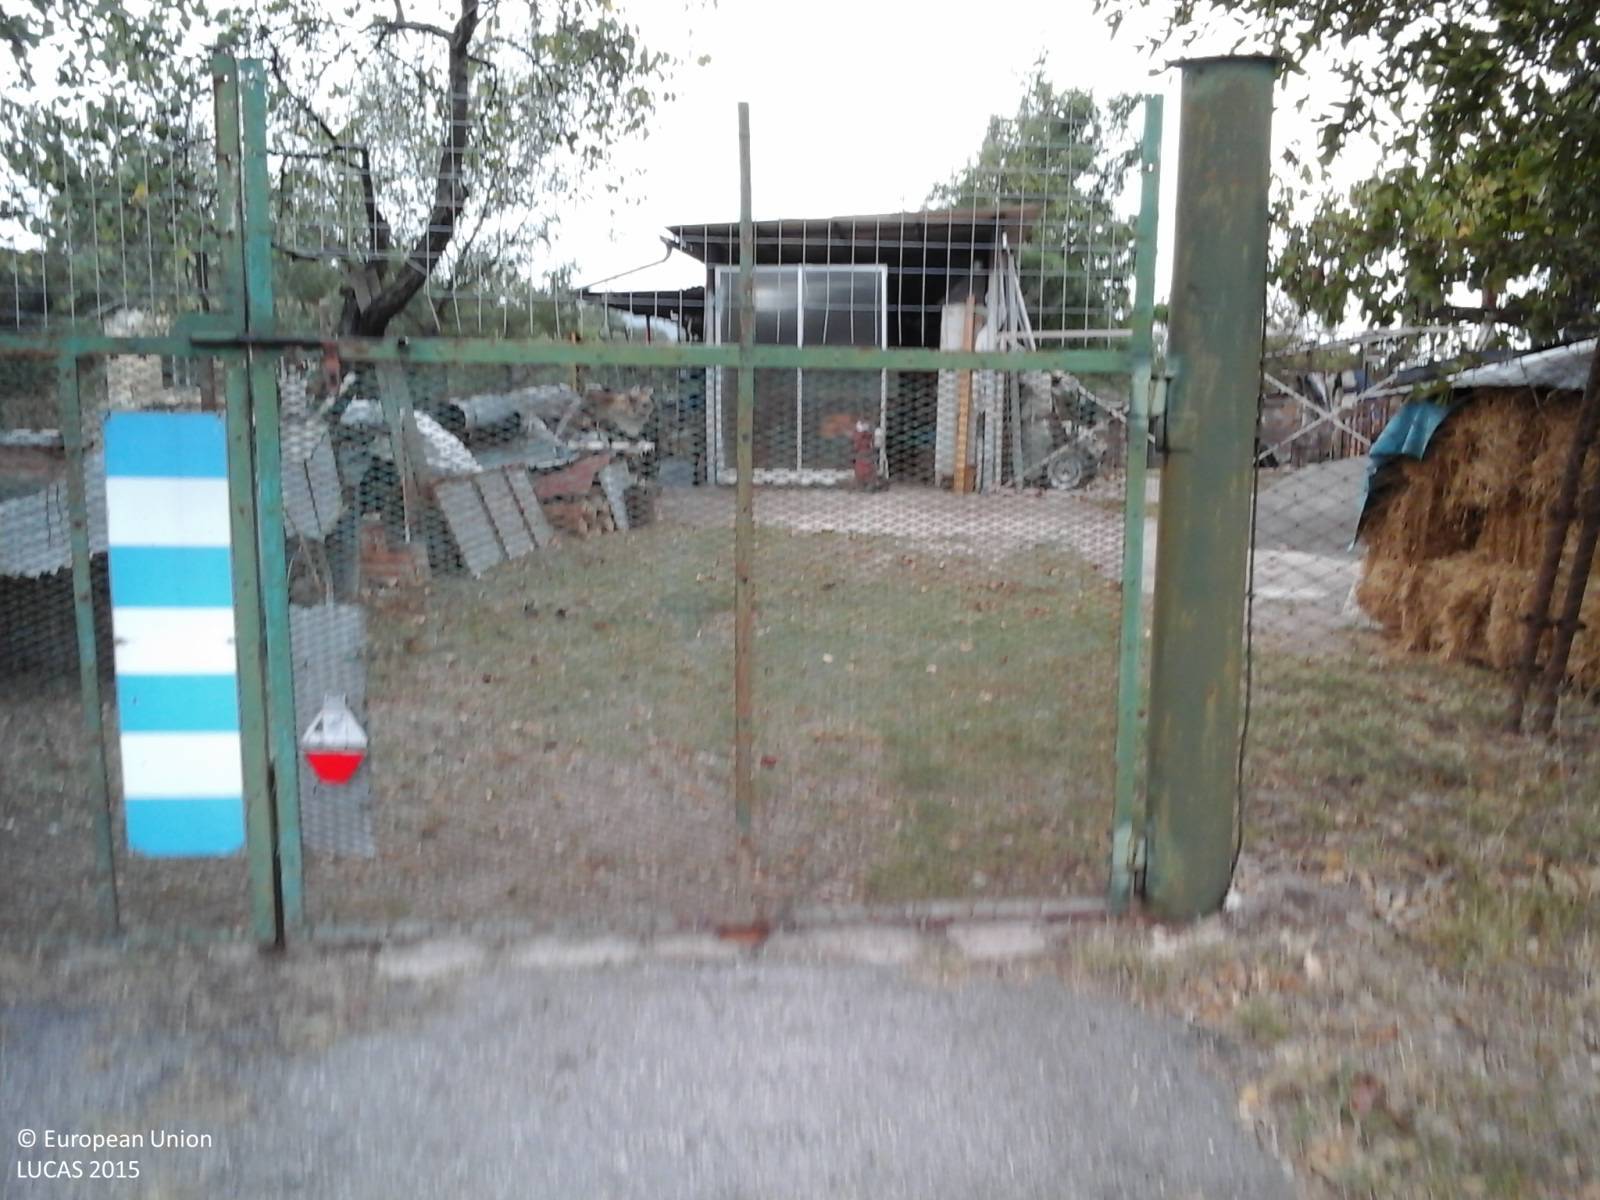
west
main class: Woodland
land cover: Broadleaved woodland
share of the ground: > 75 %
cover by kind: broadleaved forest trees 100 %
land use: Residential
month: September
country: IT
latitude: 42.4638
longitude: 12.3636
